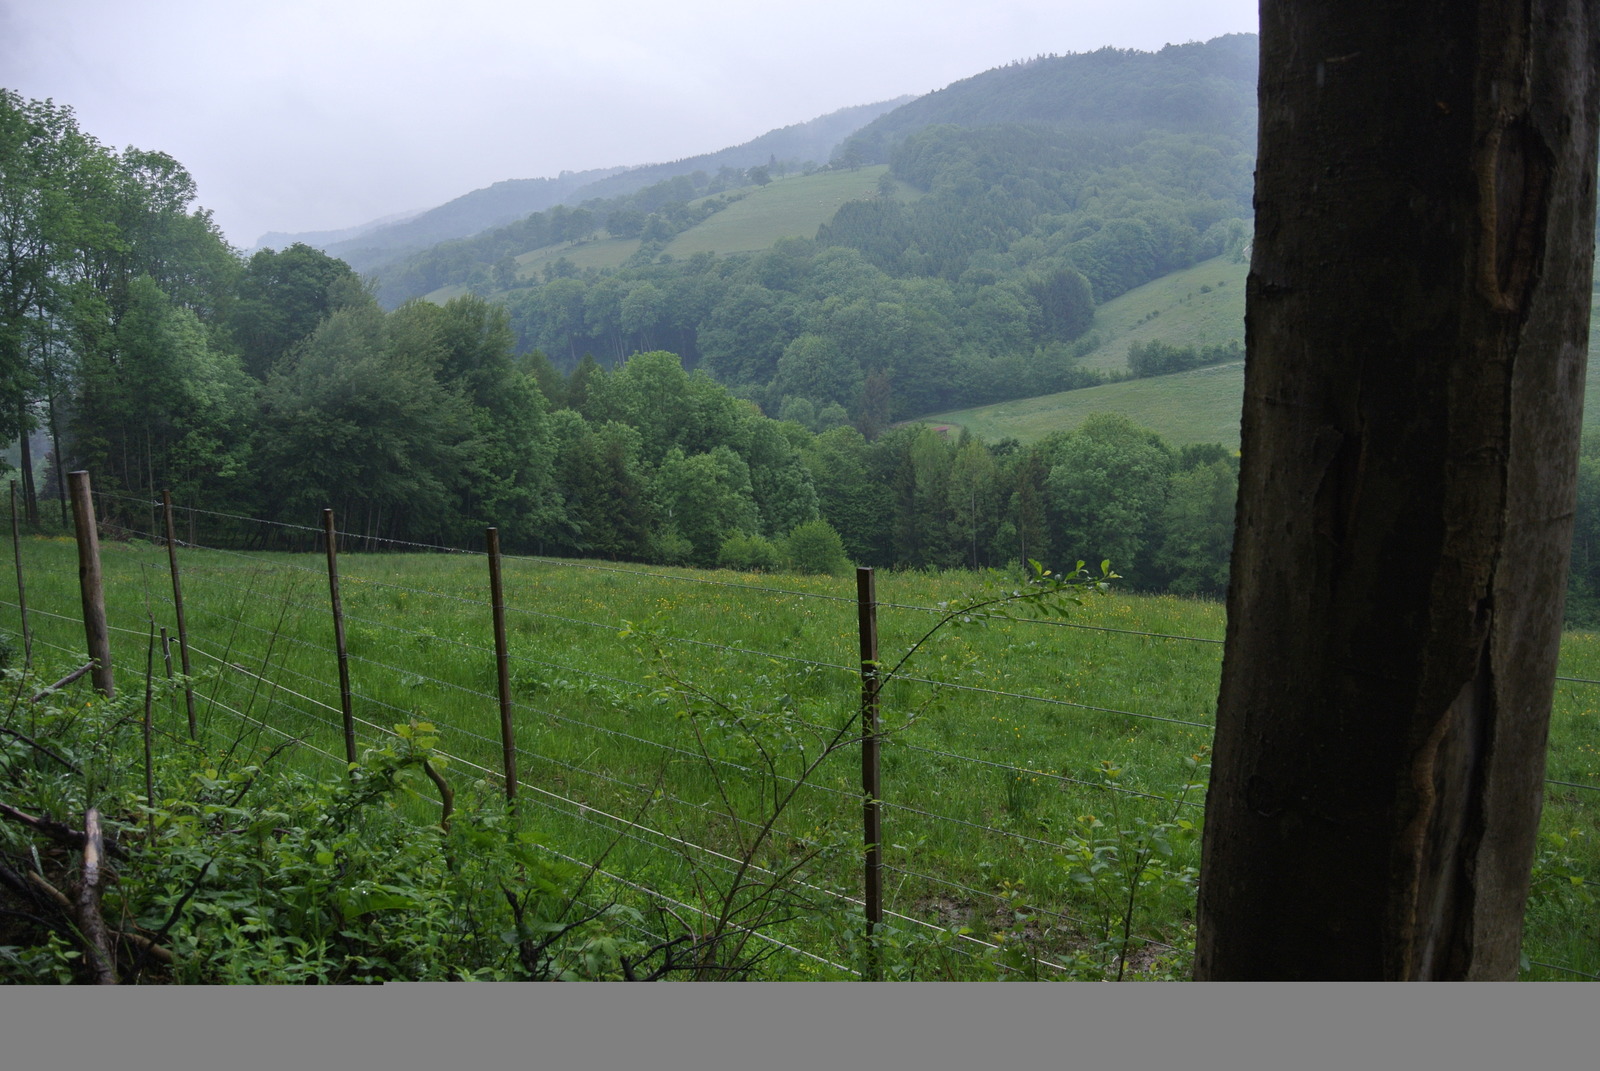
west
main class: Woodland
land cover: Broadleaved woodland
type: mesophytic deciduous forest
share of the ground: > 75 %
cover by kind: broadleaved forest trees 90 %, shrubs 10 %
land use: Forestry
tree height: > 5 m
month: May
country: AT
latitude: 48.0852
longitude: 15.8697
